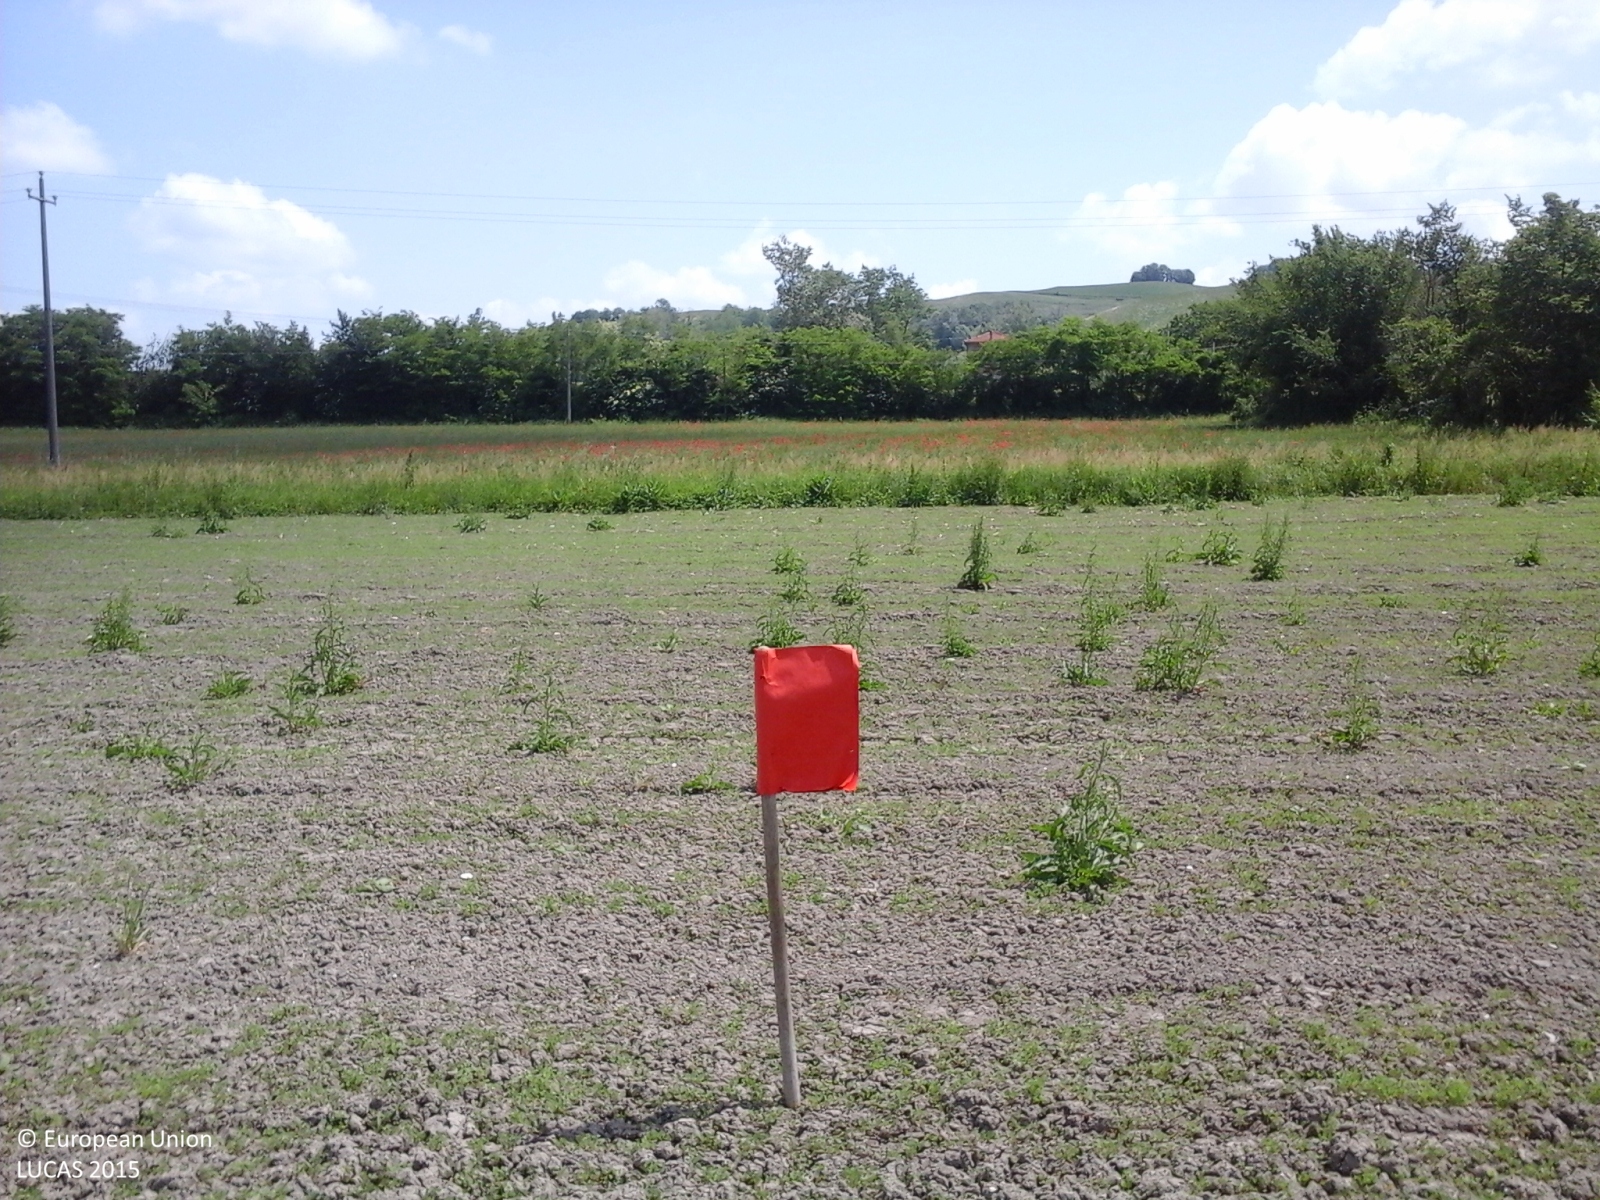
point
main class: Cropland
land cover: Lucerne
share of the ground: < 10 %
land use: Agriculture (excluding fallow land and kitchen gardens)
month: May
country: IT
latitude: 44.6570
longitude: 10.1888
